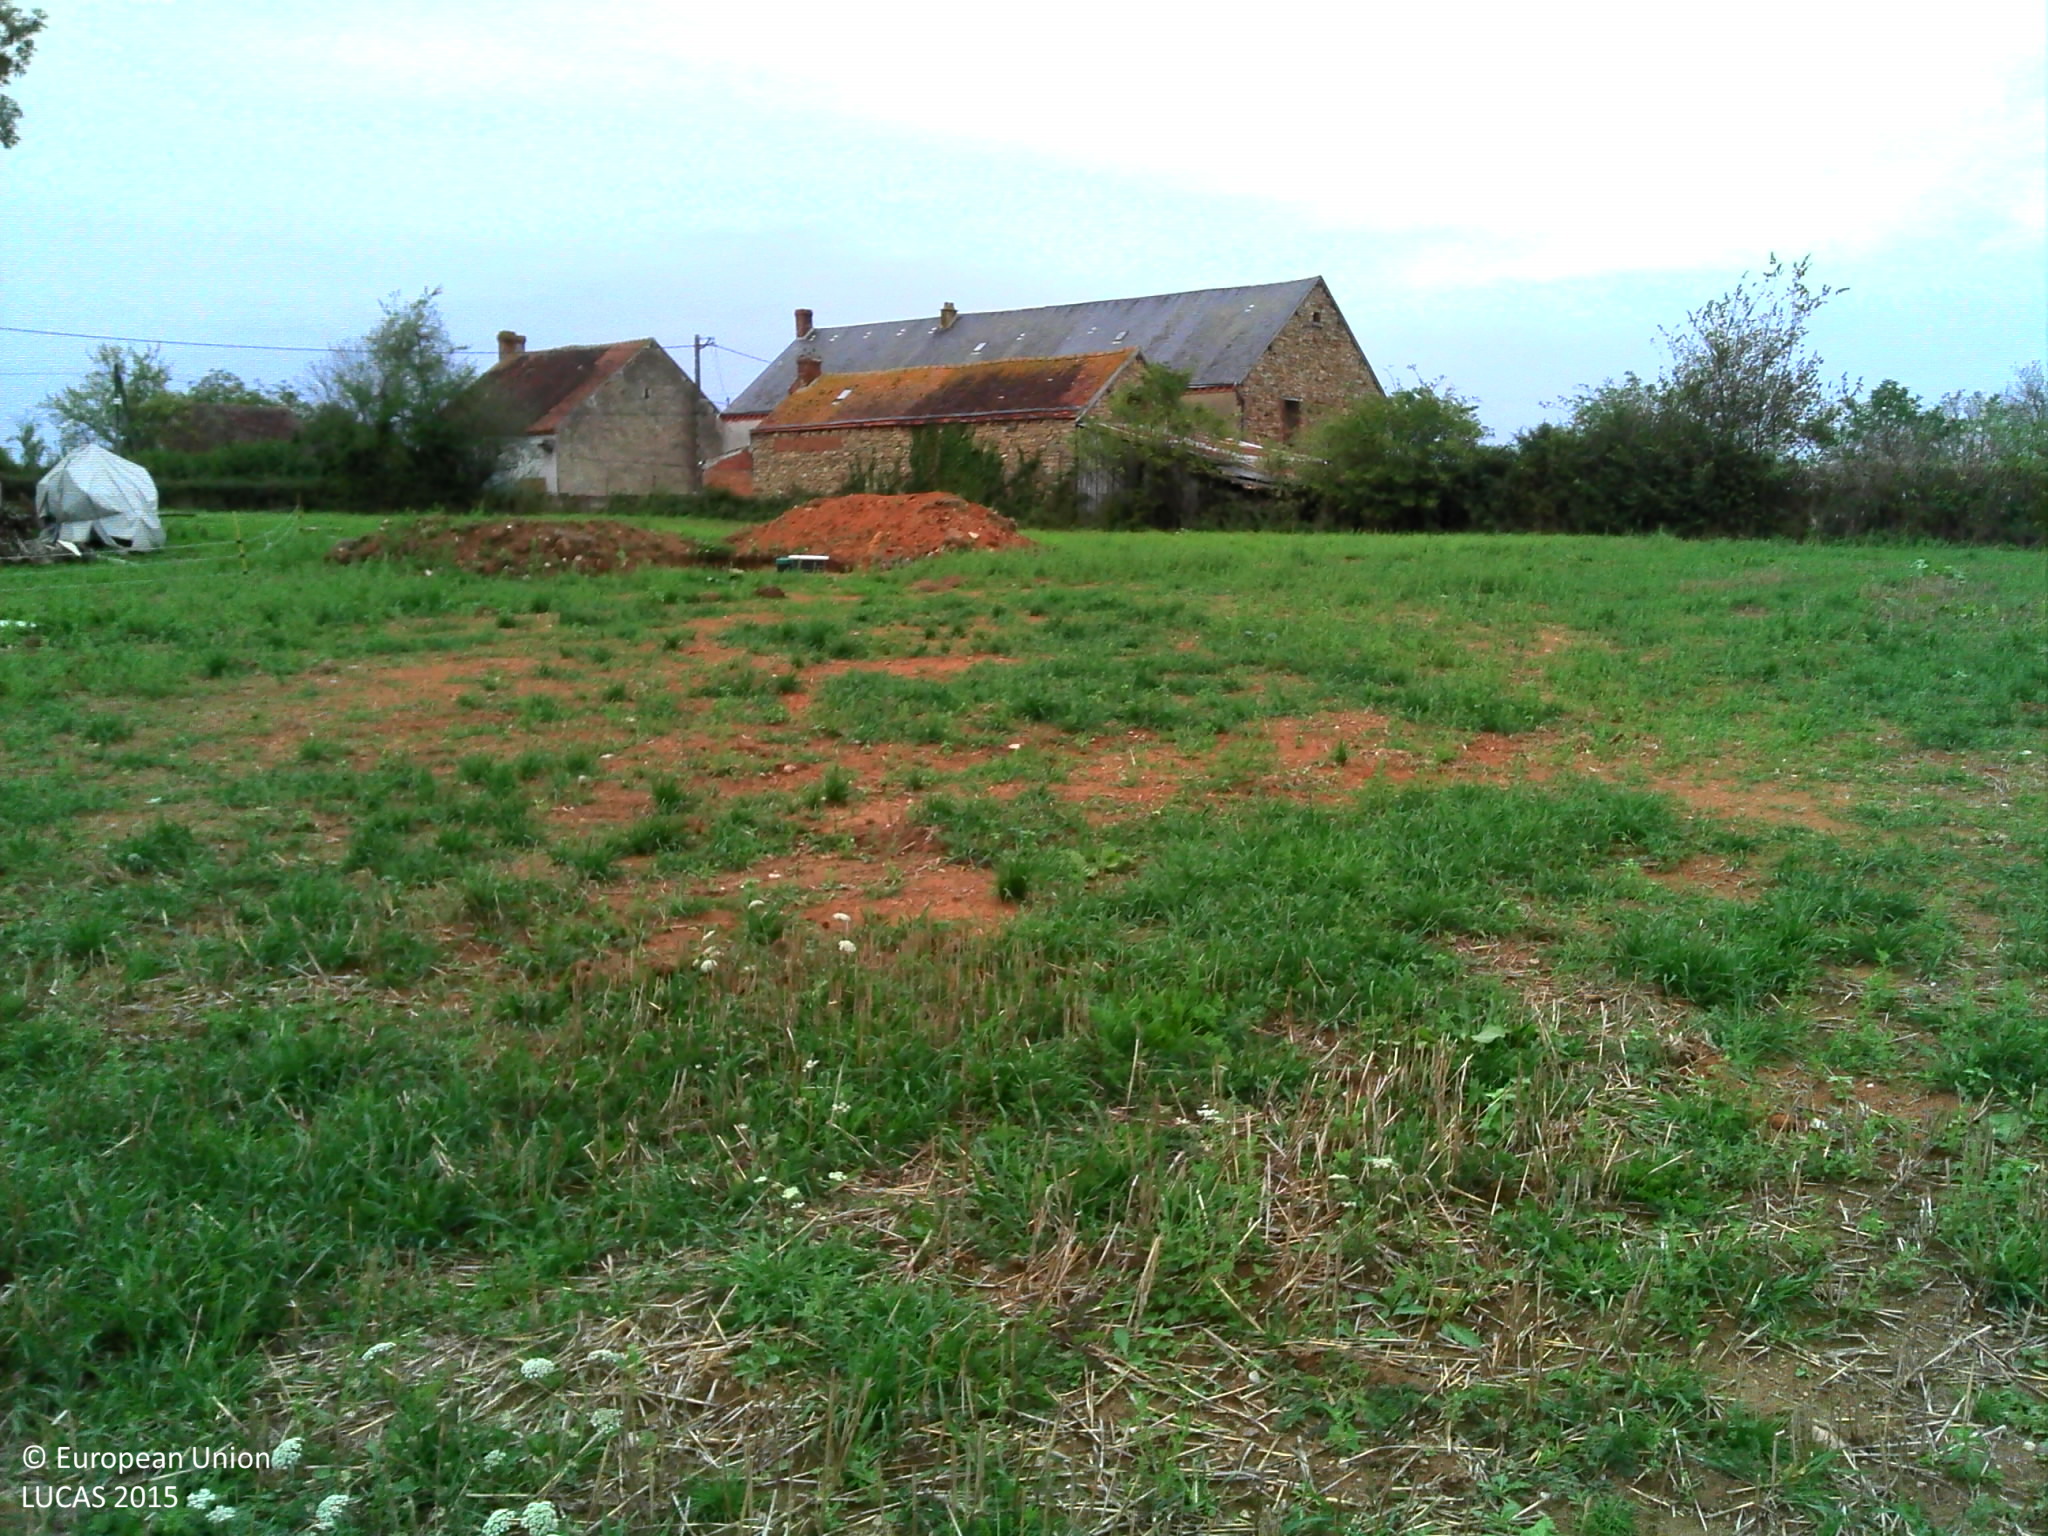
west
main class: Grassland
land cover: Spontaneously vegetated surfaces
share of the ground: 25 - 50 %
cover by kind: herbaceous plants 60 %, unconsolidated bare surface 40 %
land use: Agriculture (excluding fallow land and kitchen gardens)
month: September
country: FR
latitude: 46.5100
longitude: 1.6103
